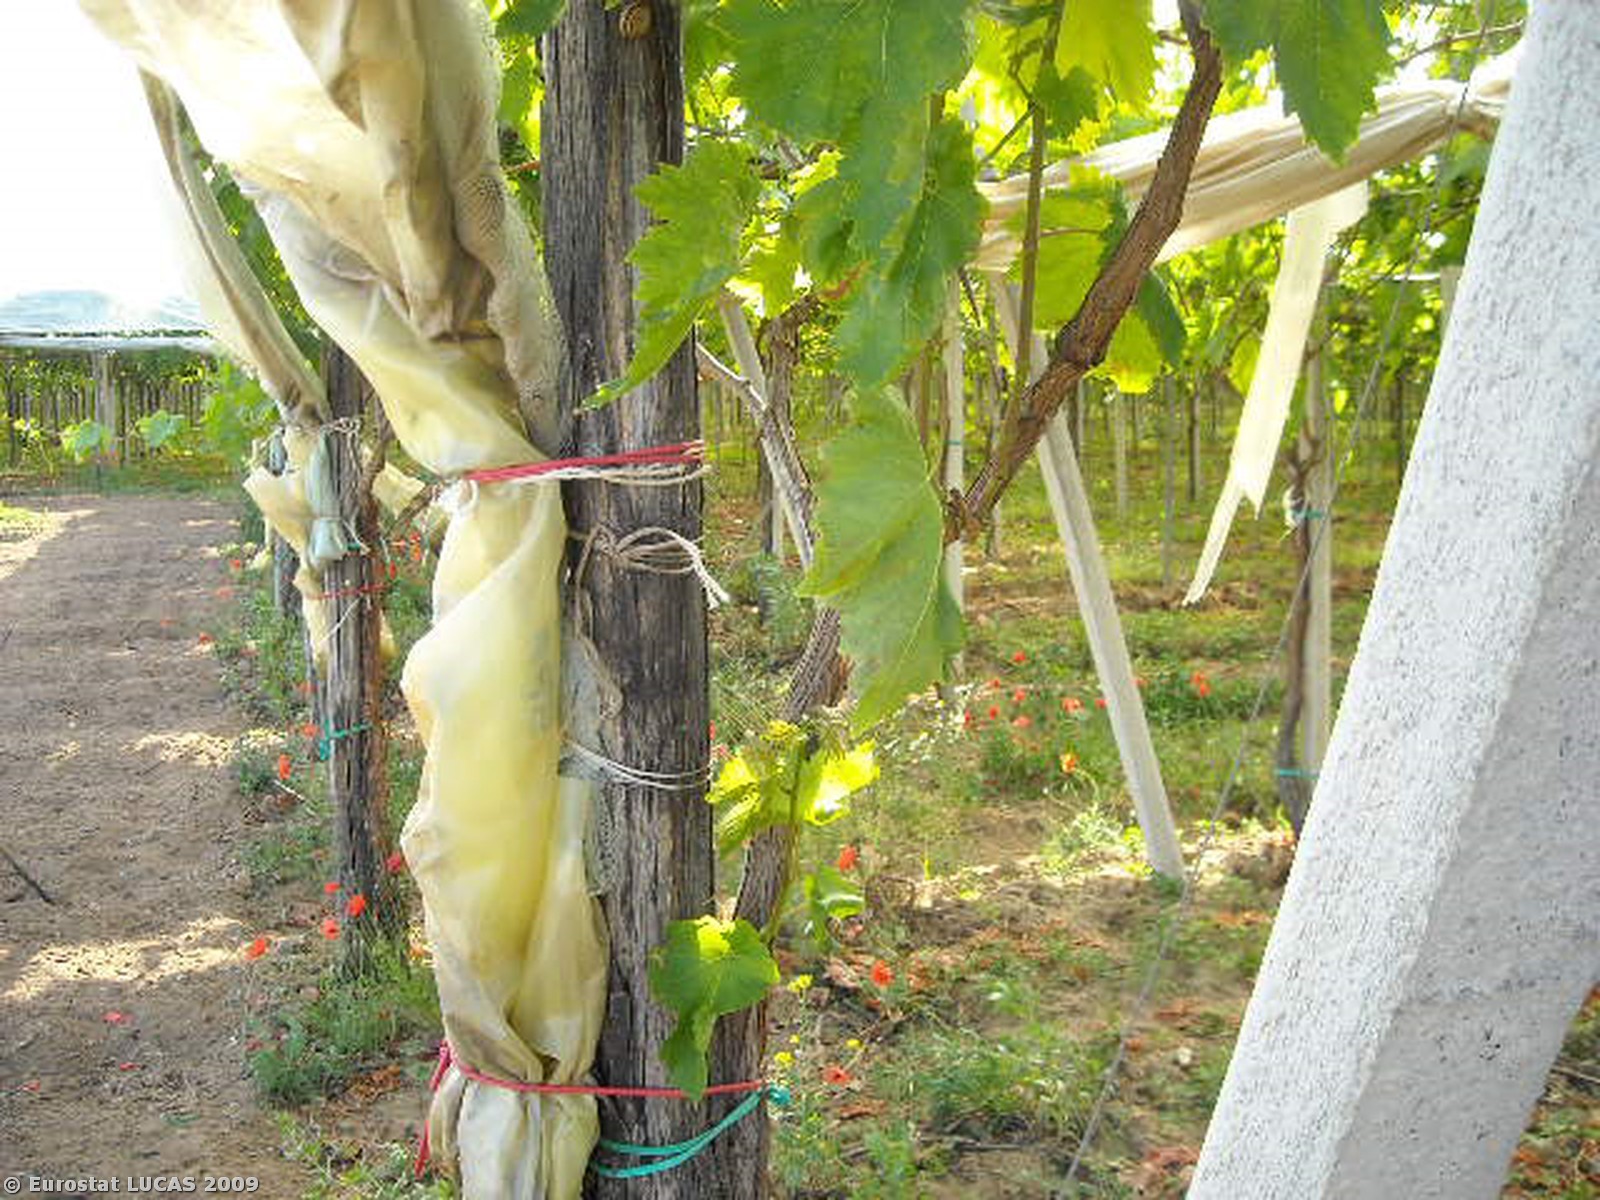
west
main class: Cropland
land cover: Vineyards
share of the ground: > 75 %
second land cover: Bare land
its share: > 75 %
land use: Agriculture (excluding fallow land and kitchen gardens)
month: May
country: IT
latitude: 40.4650
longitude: 16.8277
